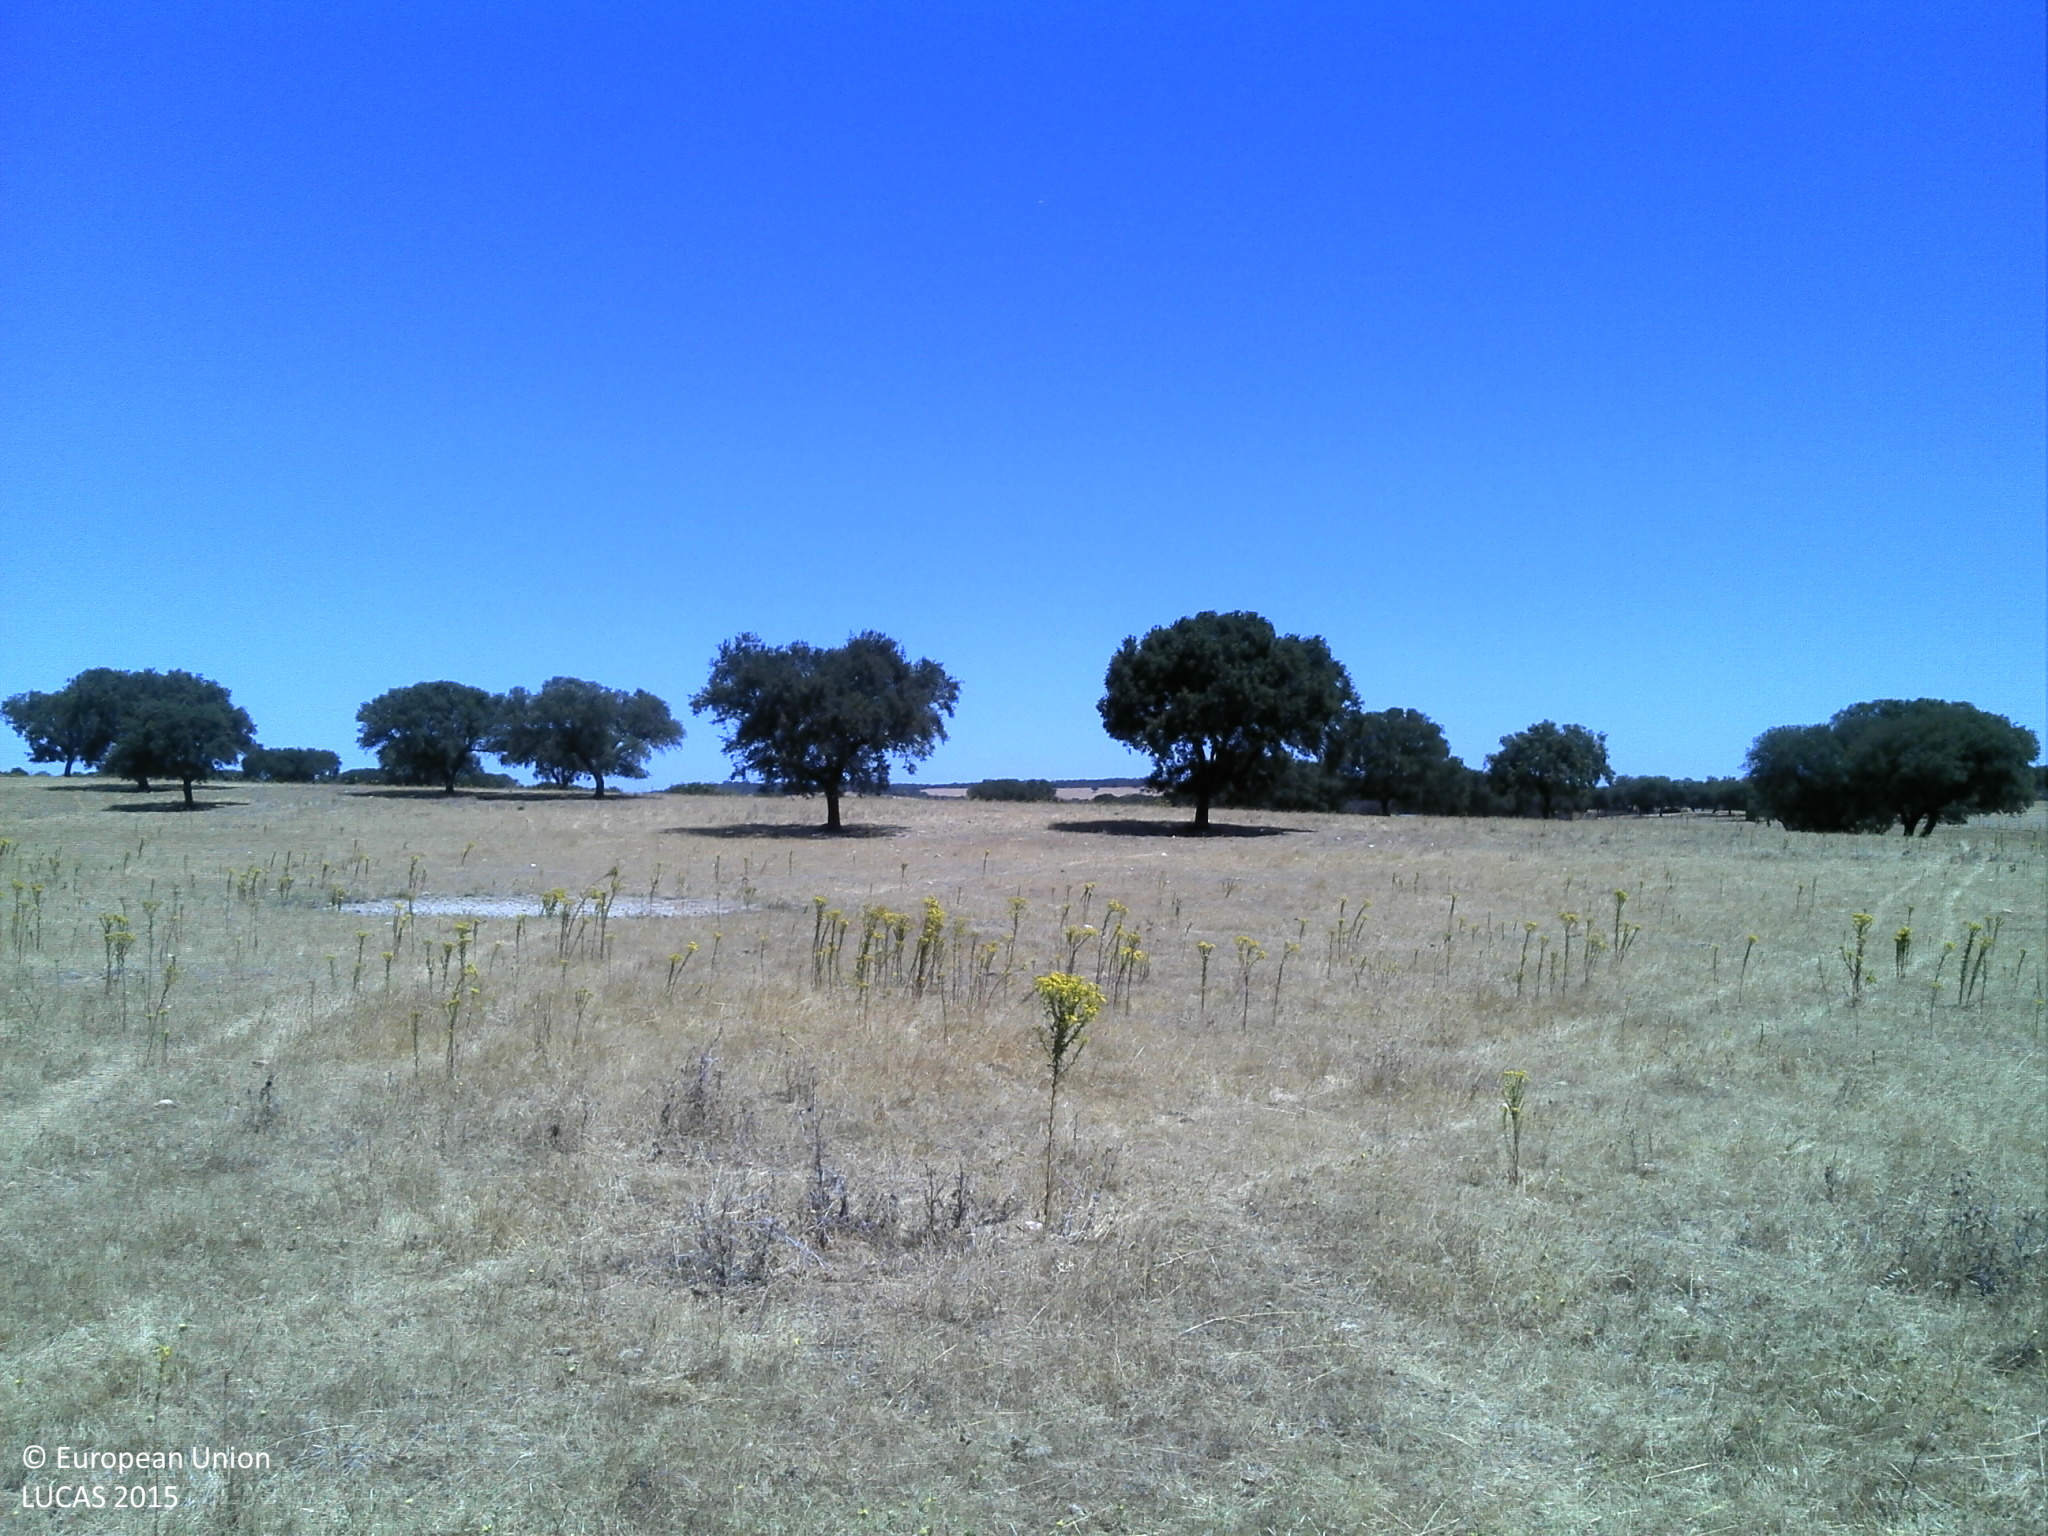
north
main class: Grassland
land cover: Grassland without tree/shrub cover
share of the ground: 25 - 50 %
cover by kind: unconsolidated bare surface 70 %, herbaceous plants 30 %
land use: Agriculture (excluding fallow land and kitchen gardens)
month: July
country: PT
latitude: 38.8784
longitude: -7.4281
